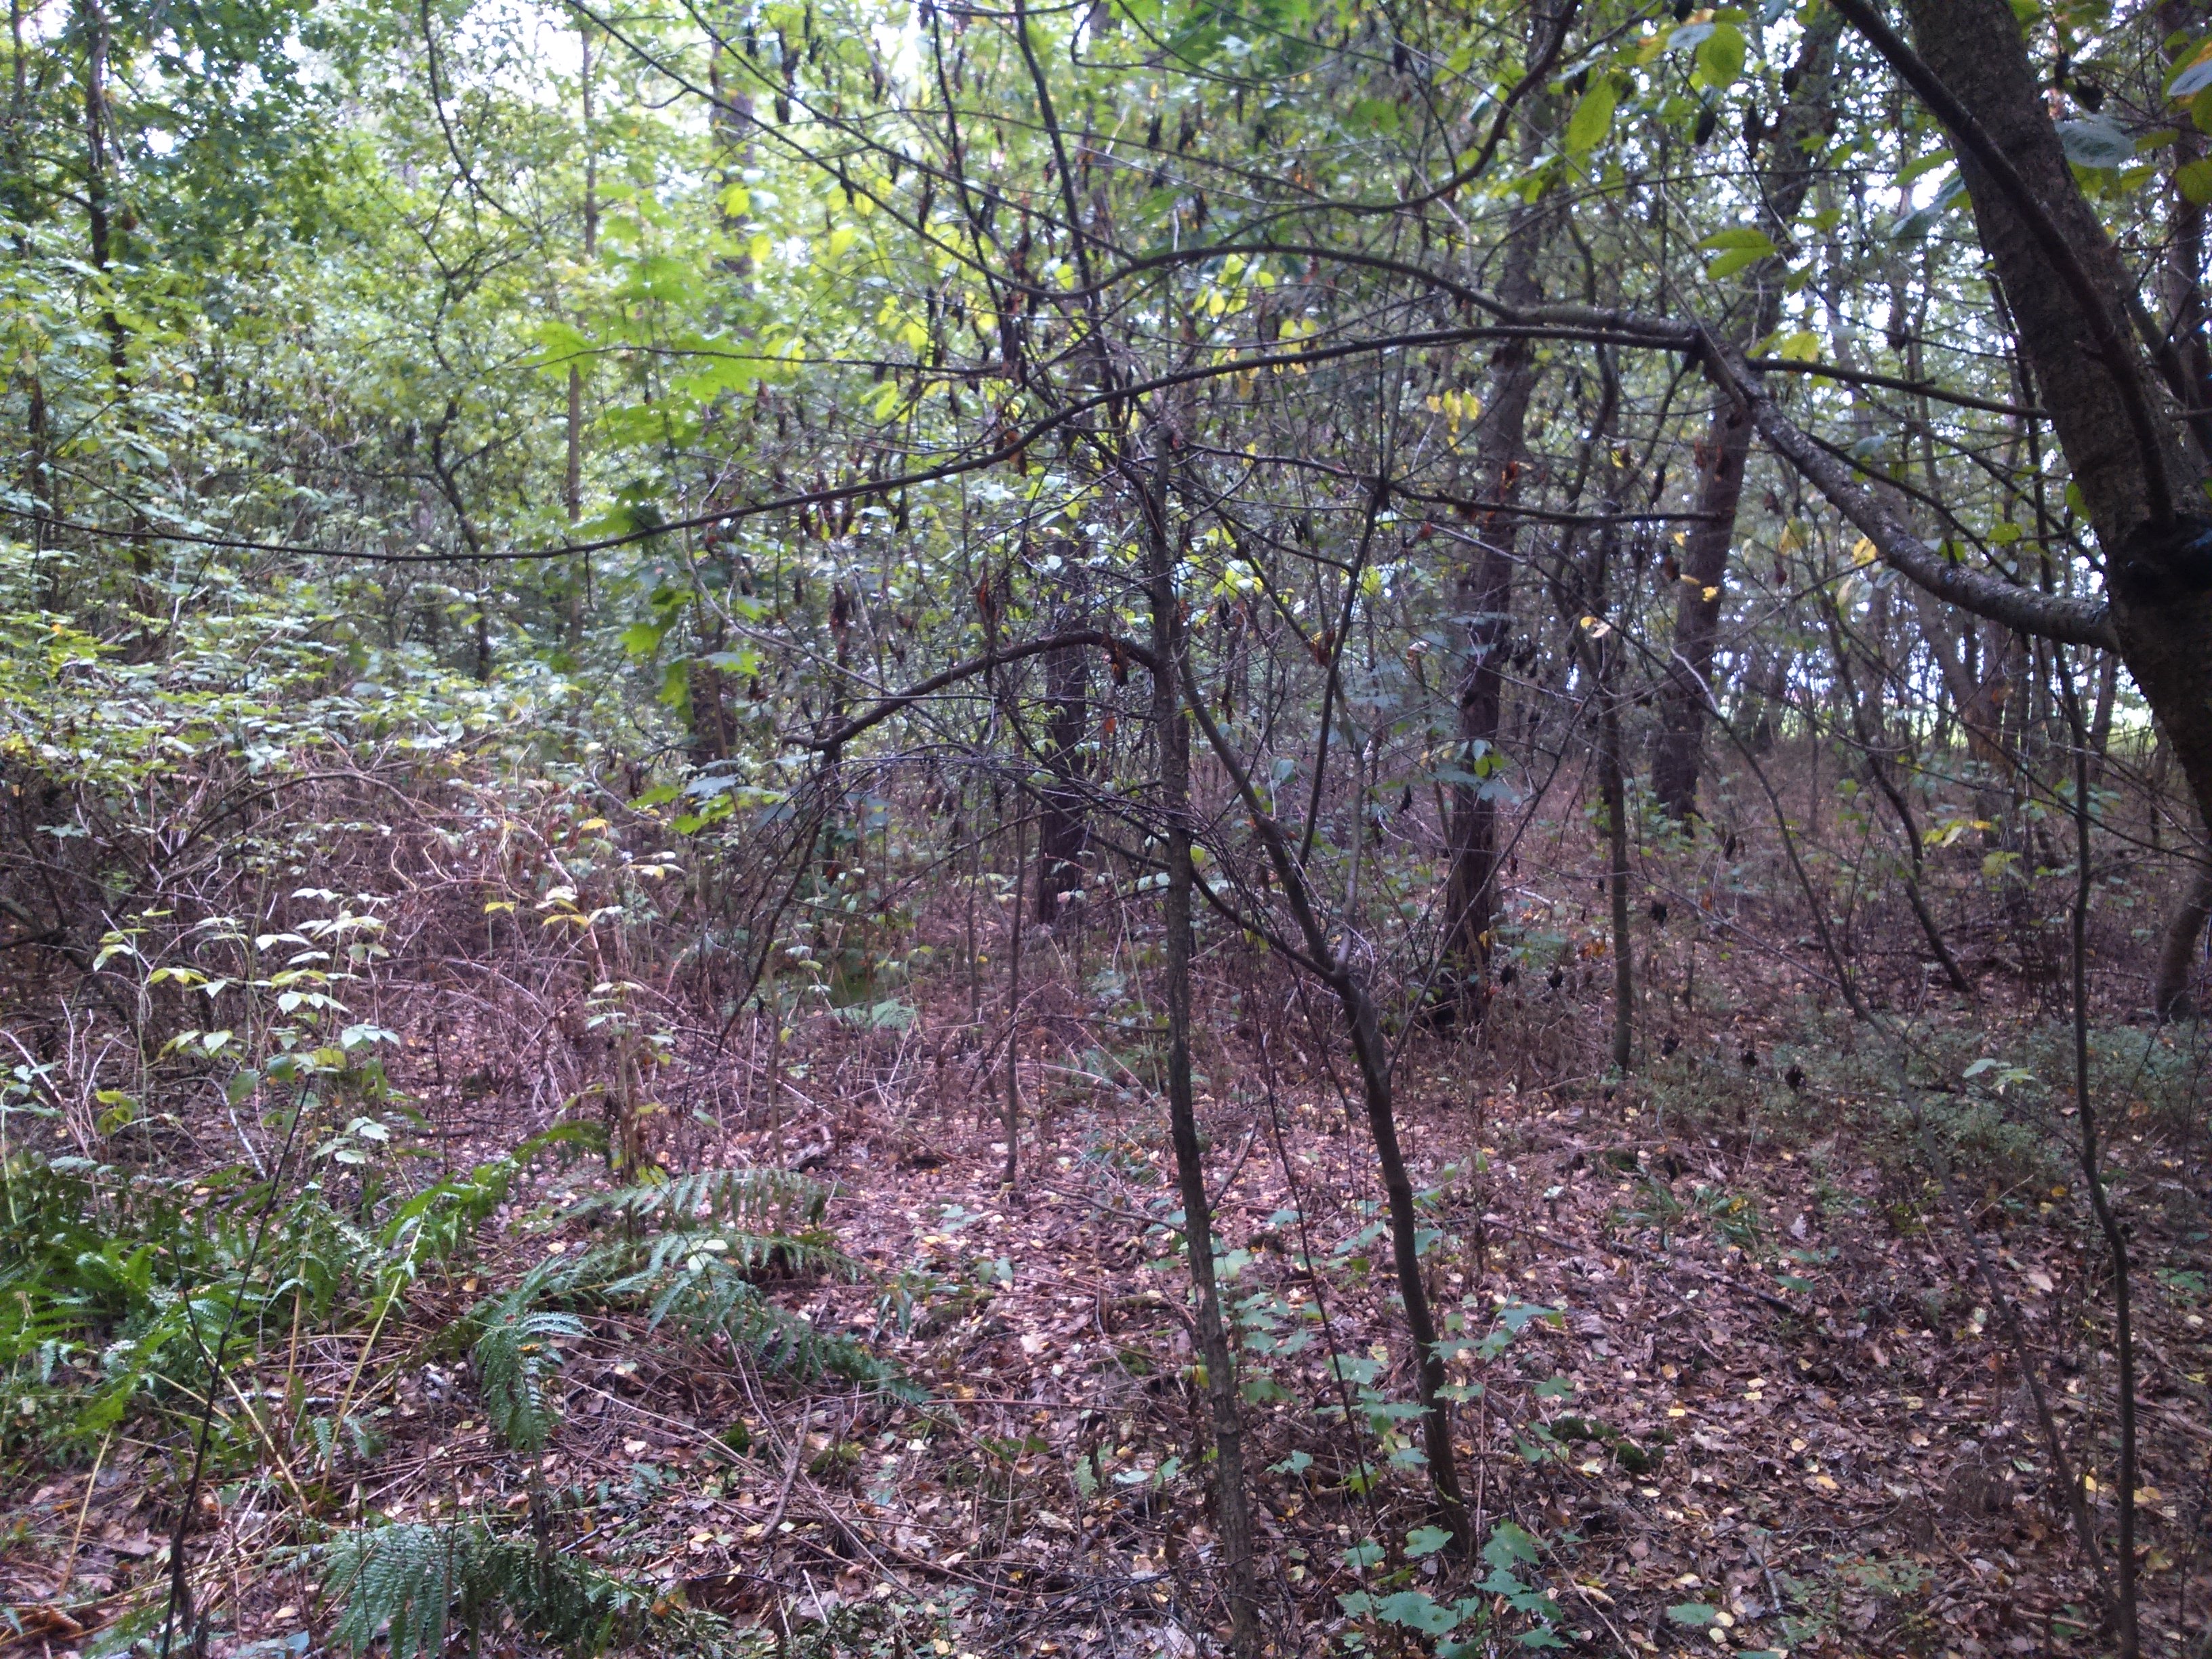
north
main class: Woodland
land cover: Other mixed woodland
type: hemiboreal forest and nemoral coniferous forest and mixed broadleaved-coniferous forest
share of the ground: > 75 %
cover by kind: broadleaved forest trees 55 %, coniferous forest trees 35 %, shrubs 10 %
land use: Forestry
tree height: > 5 m
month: September
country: PL
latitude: 52.2571
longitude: 22.1767
